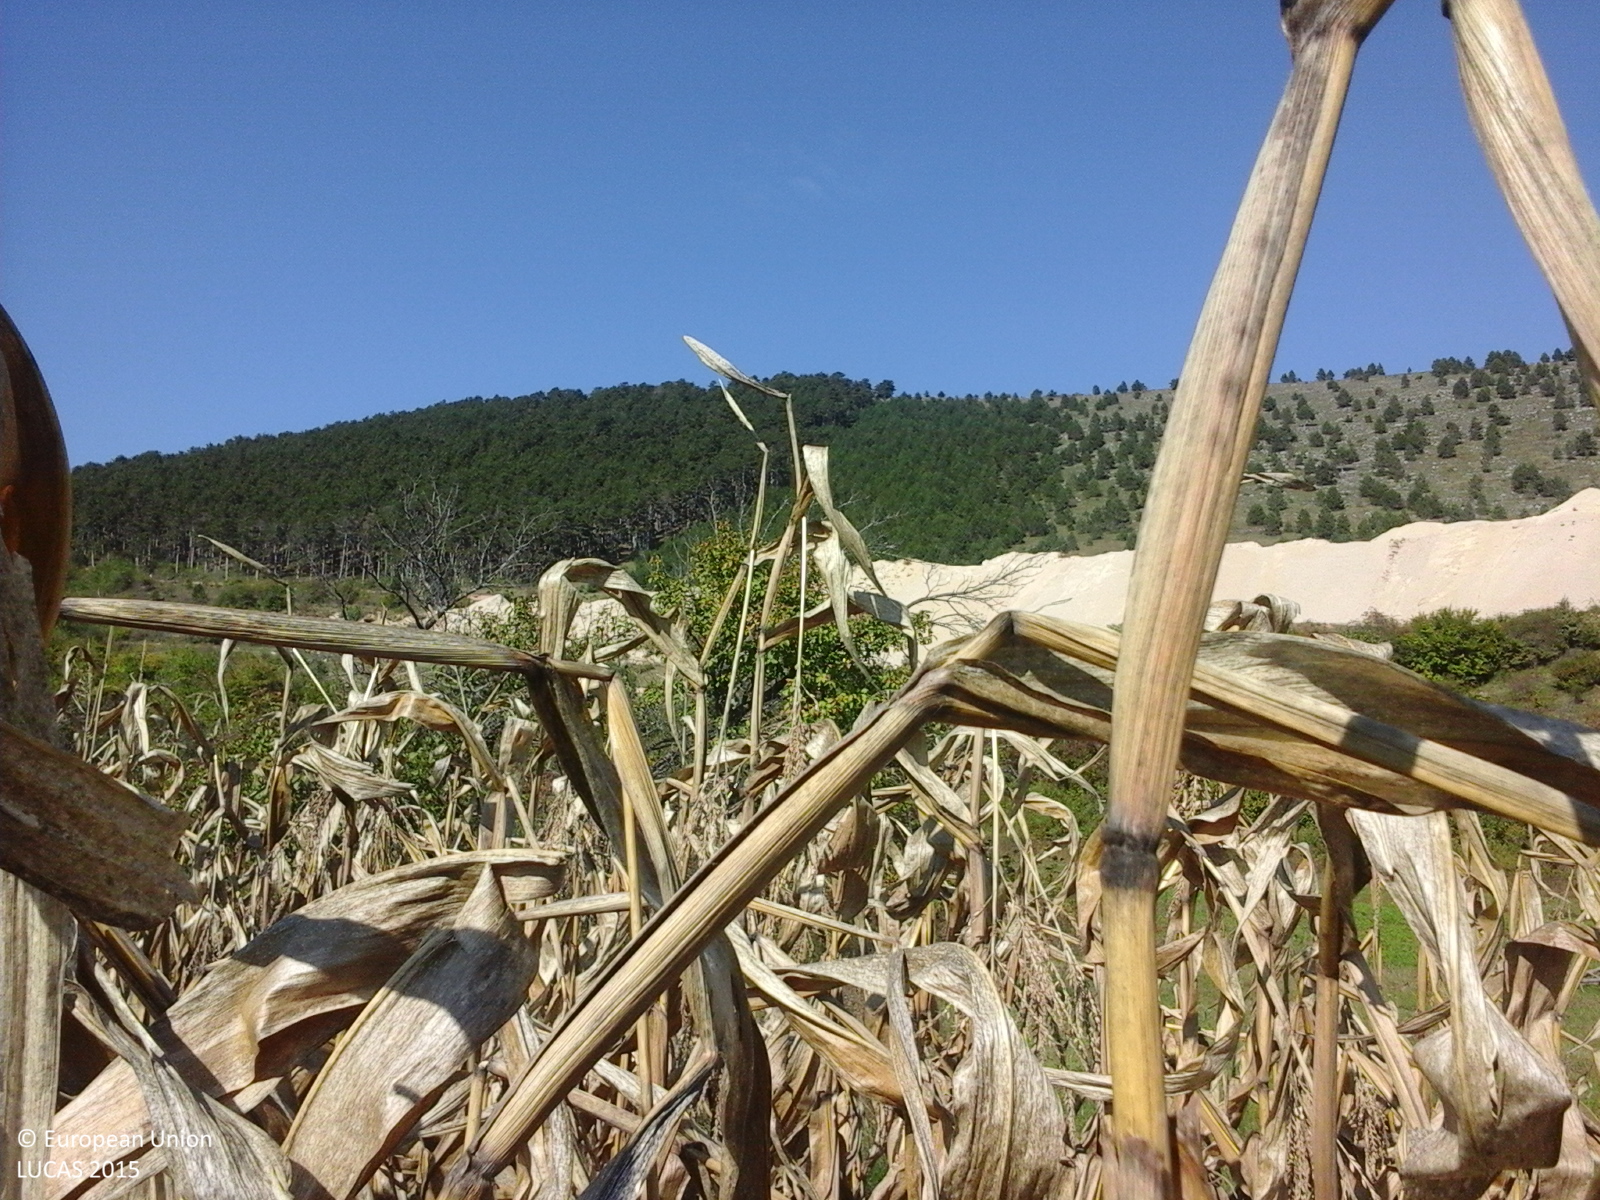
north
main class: Cropland
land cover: Maize
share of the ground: > 75 %
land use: Agriculture (excluding fallow land and kitchen gardens)
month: October
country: RO
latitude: 46.2627
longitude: 23.5998
